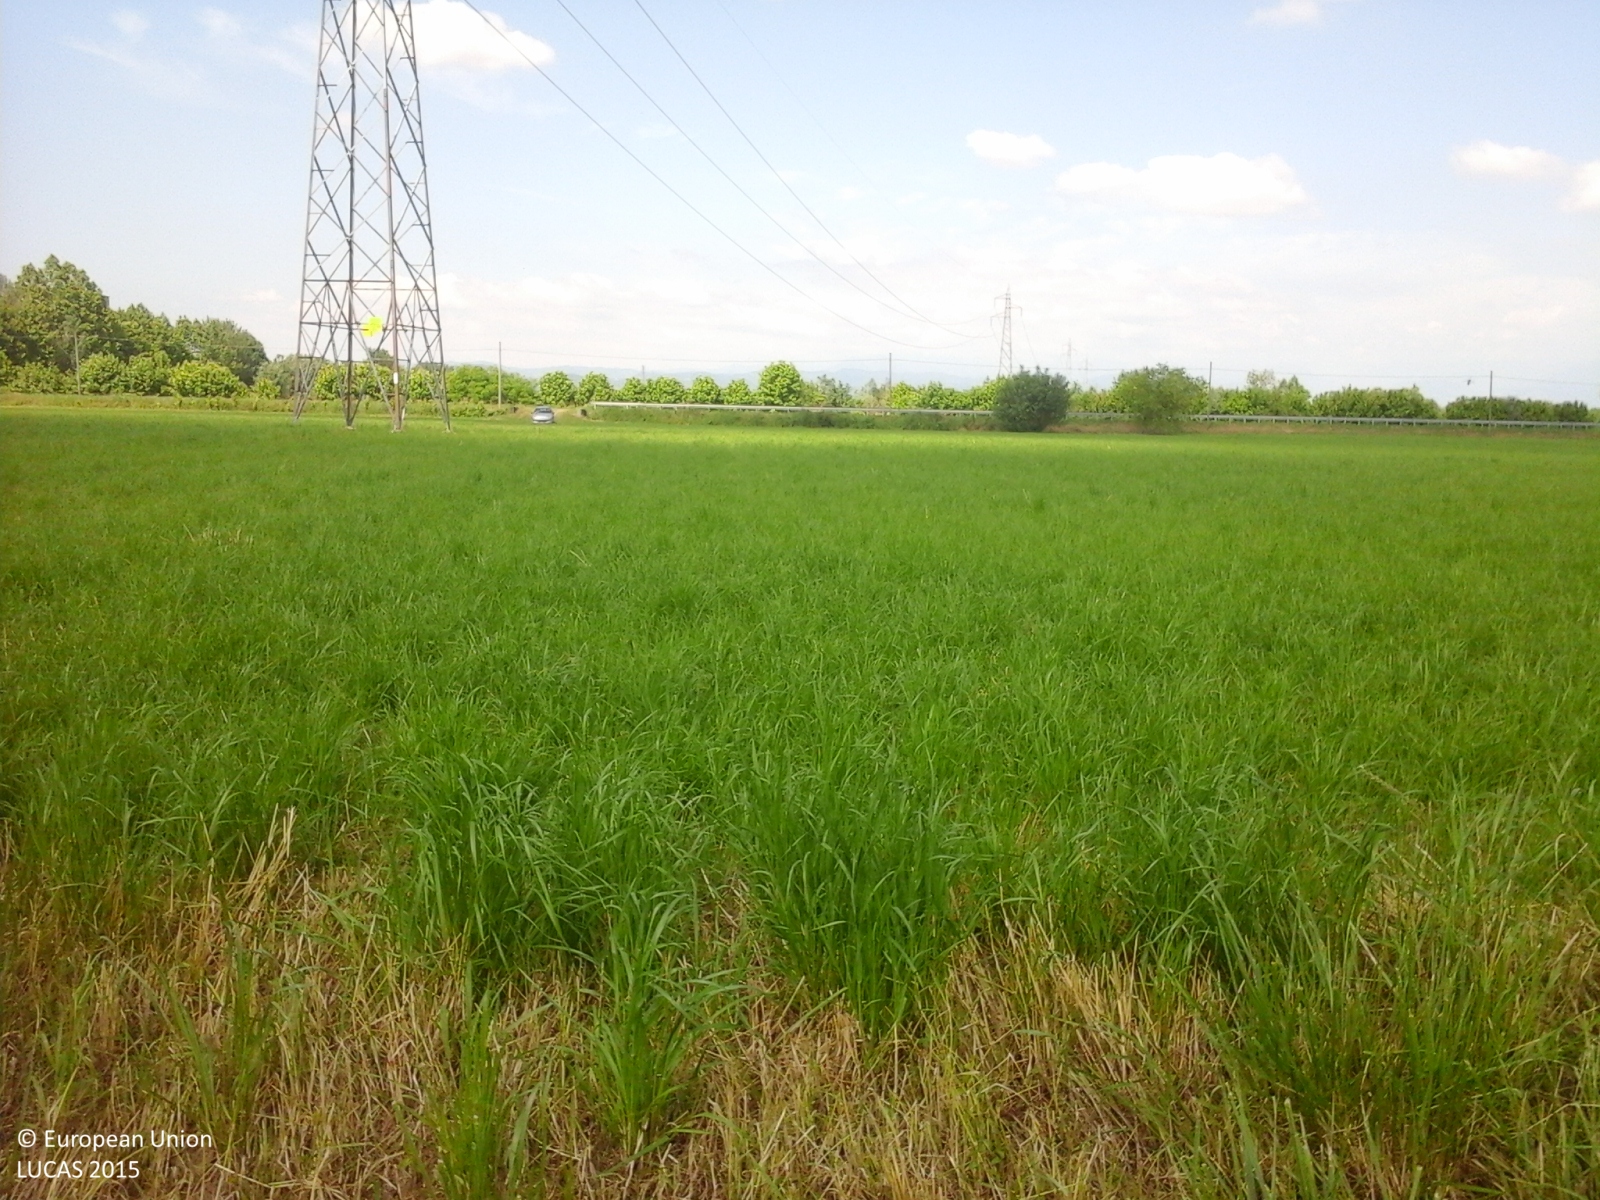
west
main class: Cropland
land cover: Maize
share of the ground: 50 - 75 %
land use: Agriculture (excluding fallow land and kitchen gardens)
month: May
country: IT
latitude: 45.6181
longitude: 11.6261
